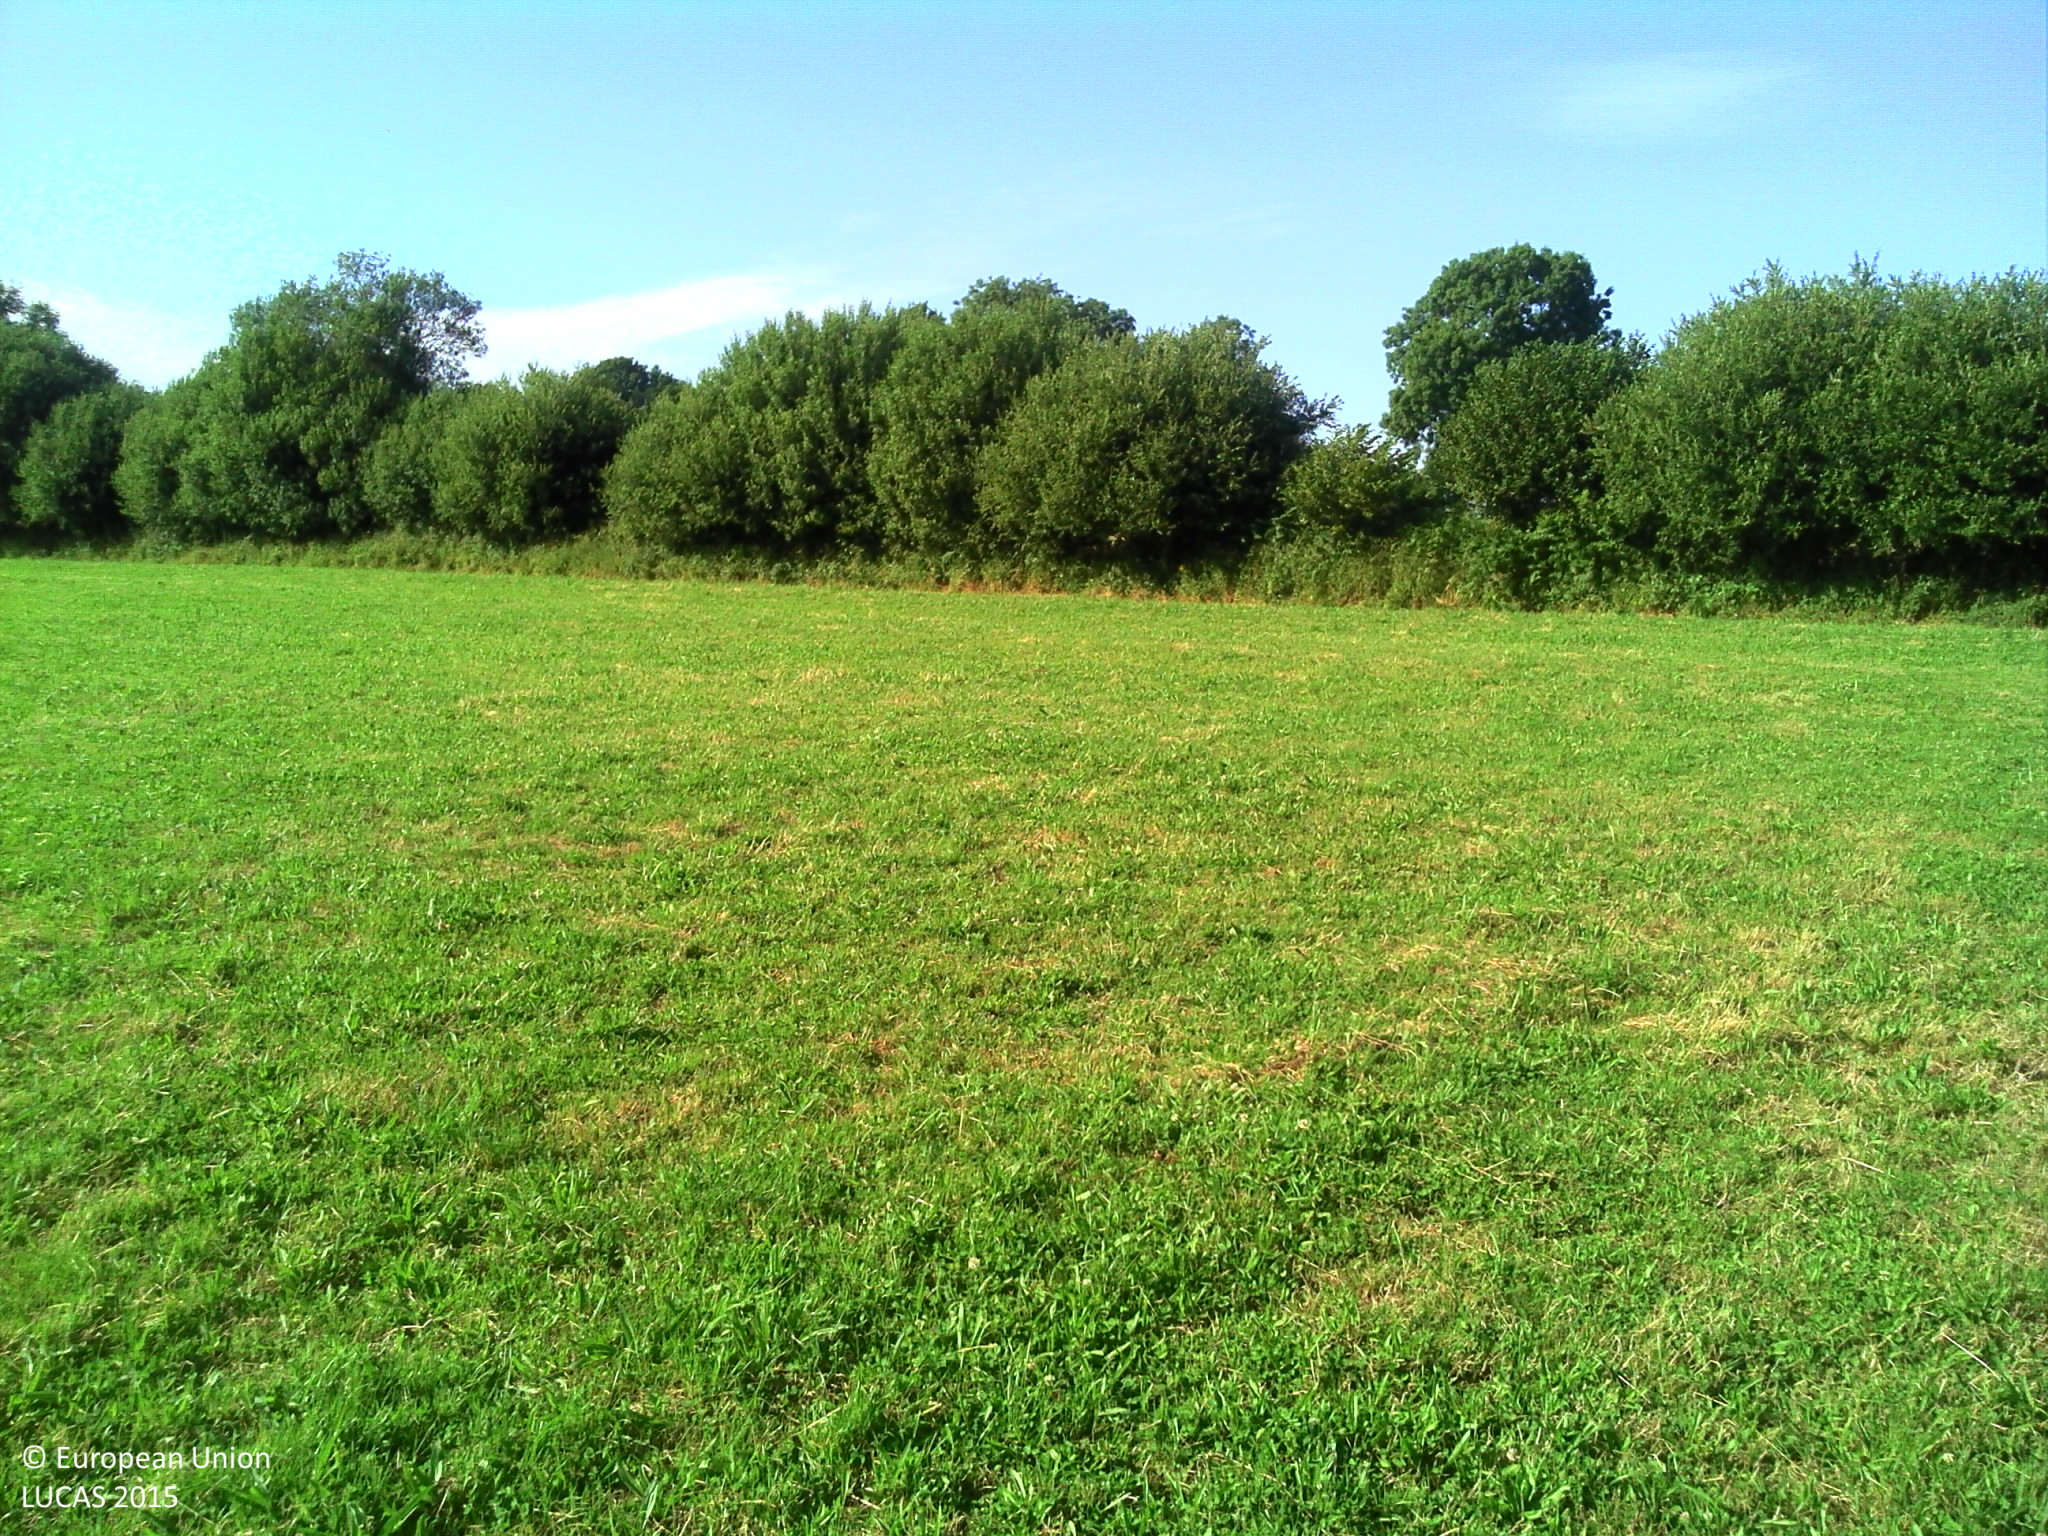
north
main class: Grassland
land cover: Grassland without tree/shrub cover
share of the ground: > 75 %
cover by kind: herbaceous plants 100 %
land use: Agriculture (excluding fallow land and kitchen gardens)
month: July
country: FR
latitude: 49.0156
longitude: -1.3542
